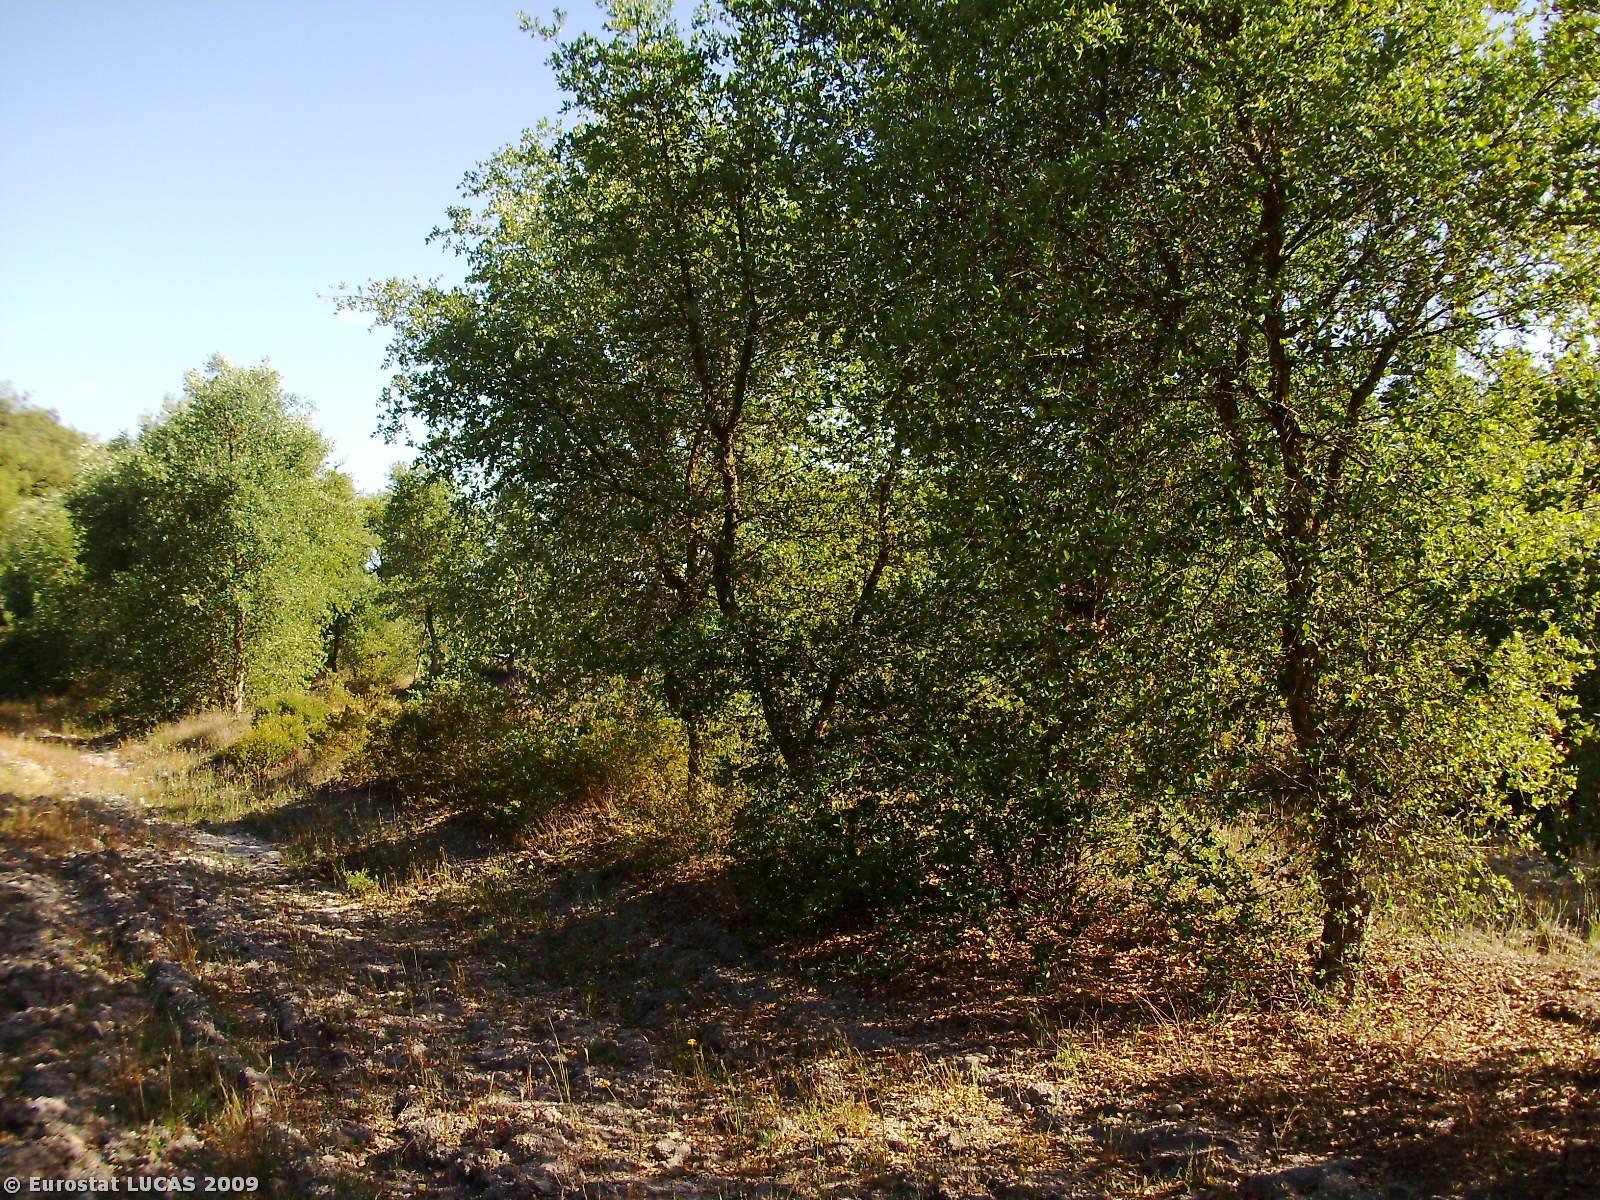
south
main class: Woodland
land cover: Broadleaved woodland
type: broadleaved evergreen forest
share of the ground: 25 - 50 %
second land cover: Bare land
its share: 50 - 75 %
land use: Forestry
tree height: > 5 m
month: May
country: PT
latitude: 39.2909
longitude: -7.9915
